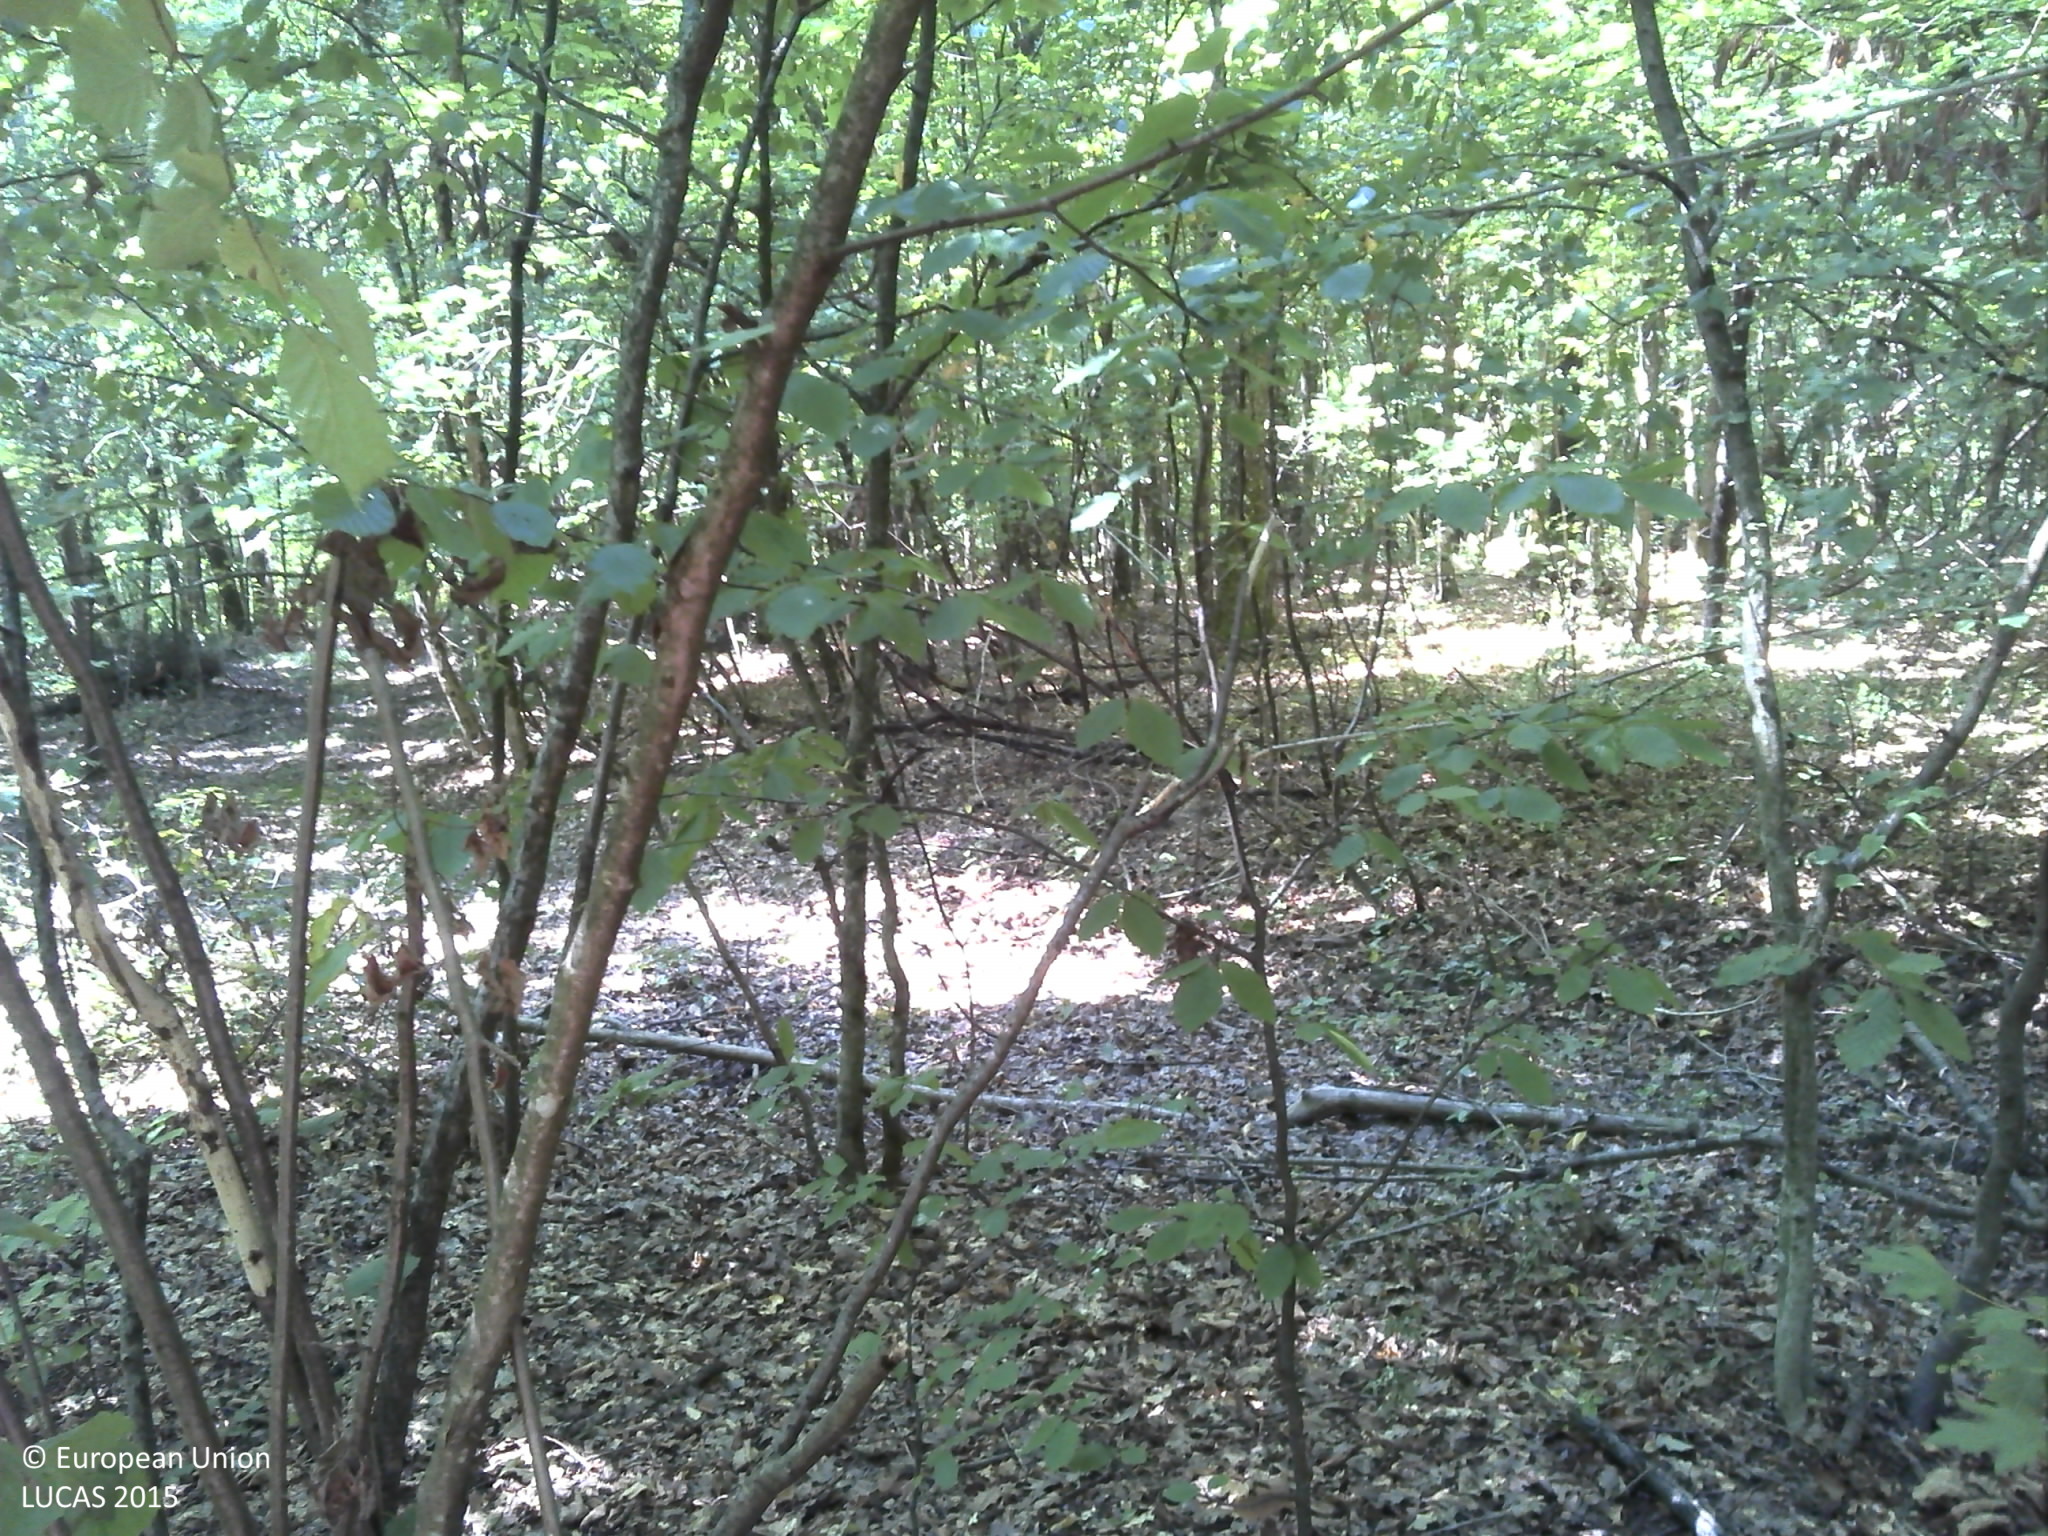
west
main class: Woodland
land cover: Broadleaved woodland
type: acidophilous oak and oak-birch forest
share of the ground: > 75 %
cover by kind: broadleaved forest trees 100 %
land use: Forestry
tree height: > 5 m
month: August
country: HR
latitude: 45.3601
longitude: 16.4701
